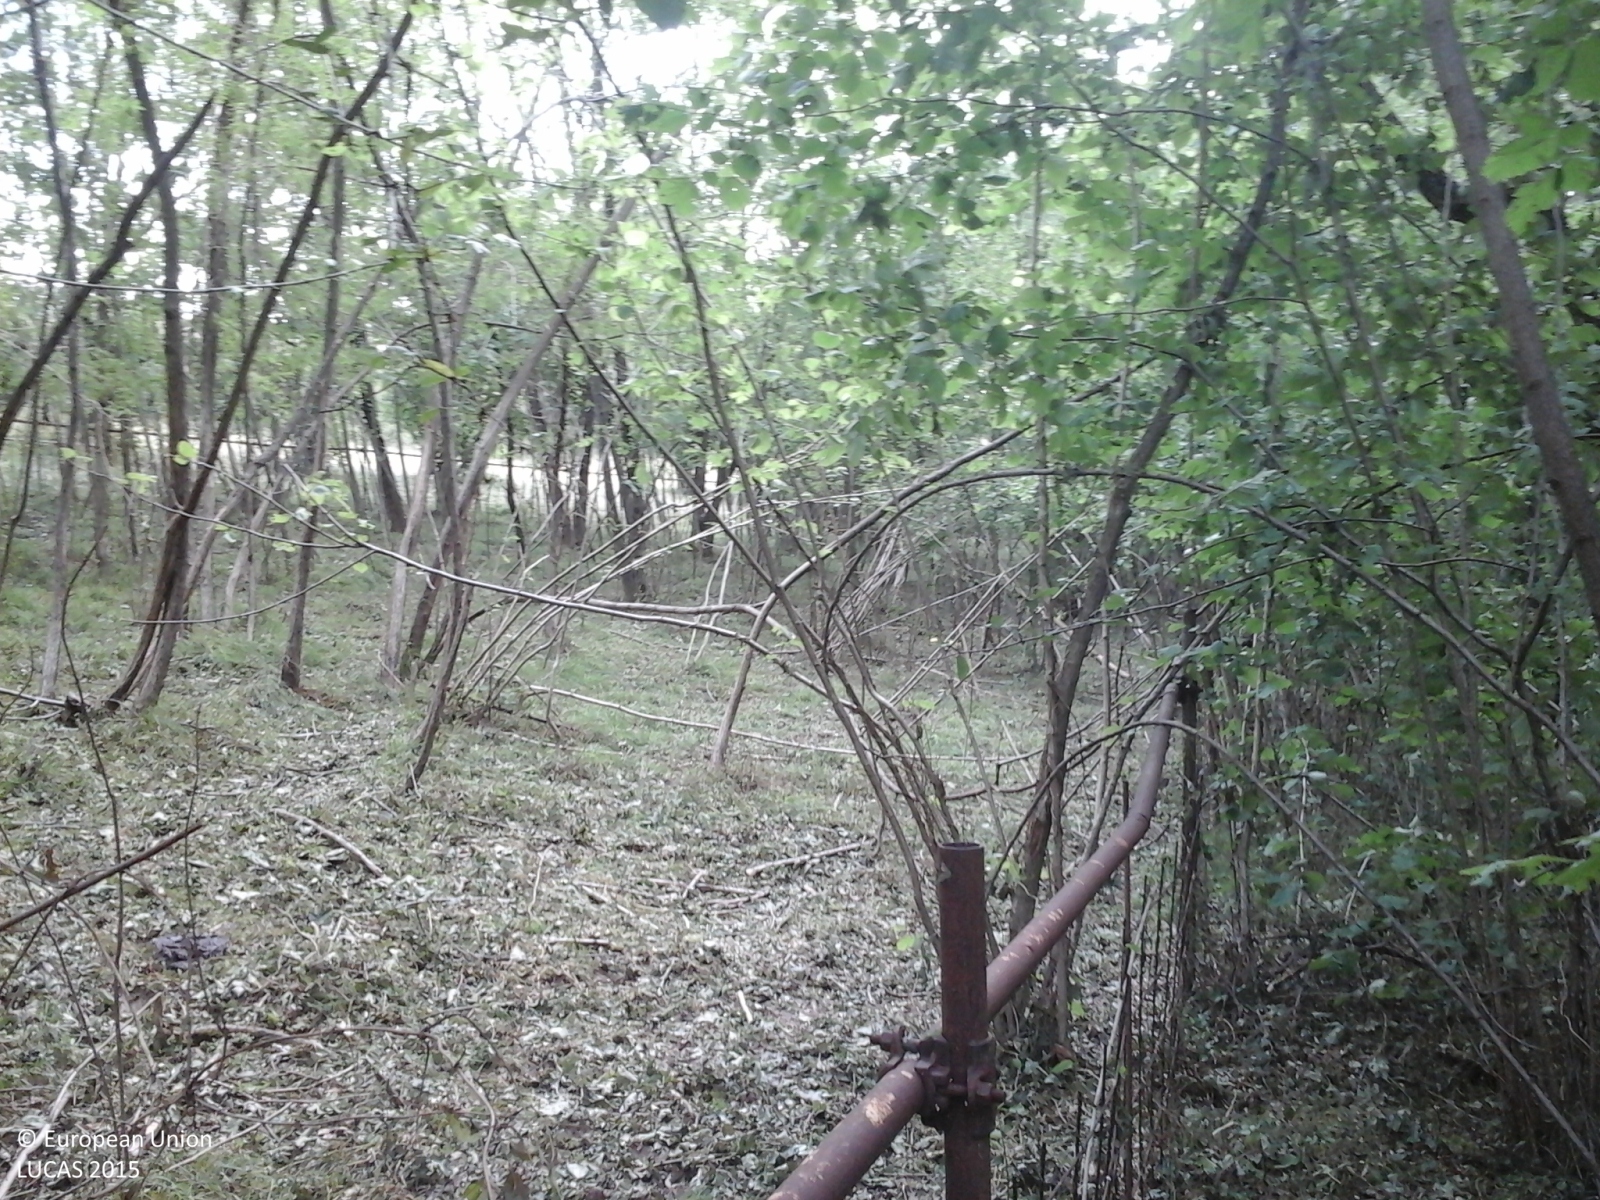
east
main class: Woodland
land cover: Broadleaved woodland
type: thermophilous deciduous forest
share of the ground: > 75 %
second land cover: Grassland without tree/shrub cover
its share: > 75 %
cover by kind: broadleaved forest trees 100 %
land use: Forestry
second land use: Agriculture (excluding fallow land and kitchen gardens)
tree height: > 5 m
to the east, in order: Broadleaved woodland; Grassland without tree/shrub cover; Fences; Broadleaved woodland; Grassland with sparse tree/shrub cover; Grassland without tree/shrub cover; Vineyards; Grassland without tree/shrub cover; Apple fruit; Broadleaved woodland; Tracks; Broadleaved woodland; Grassland without tree/shrub cover; Vineyards
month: May
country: IT
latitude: 44.7842
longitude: 7.2877
